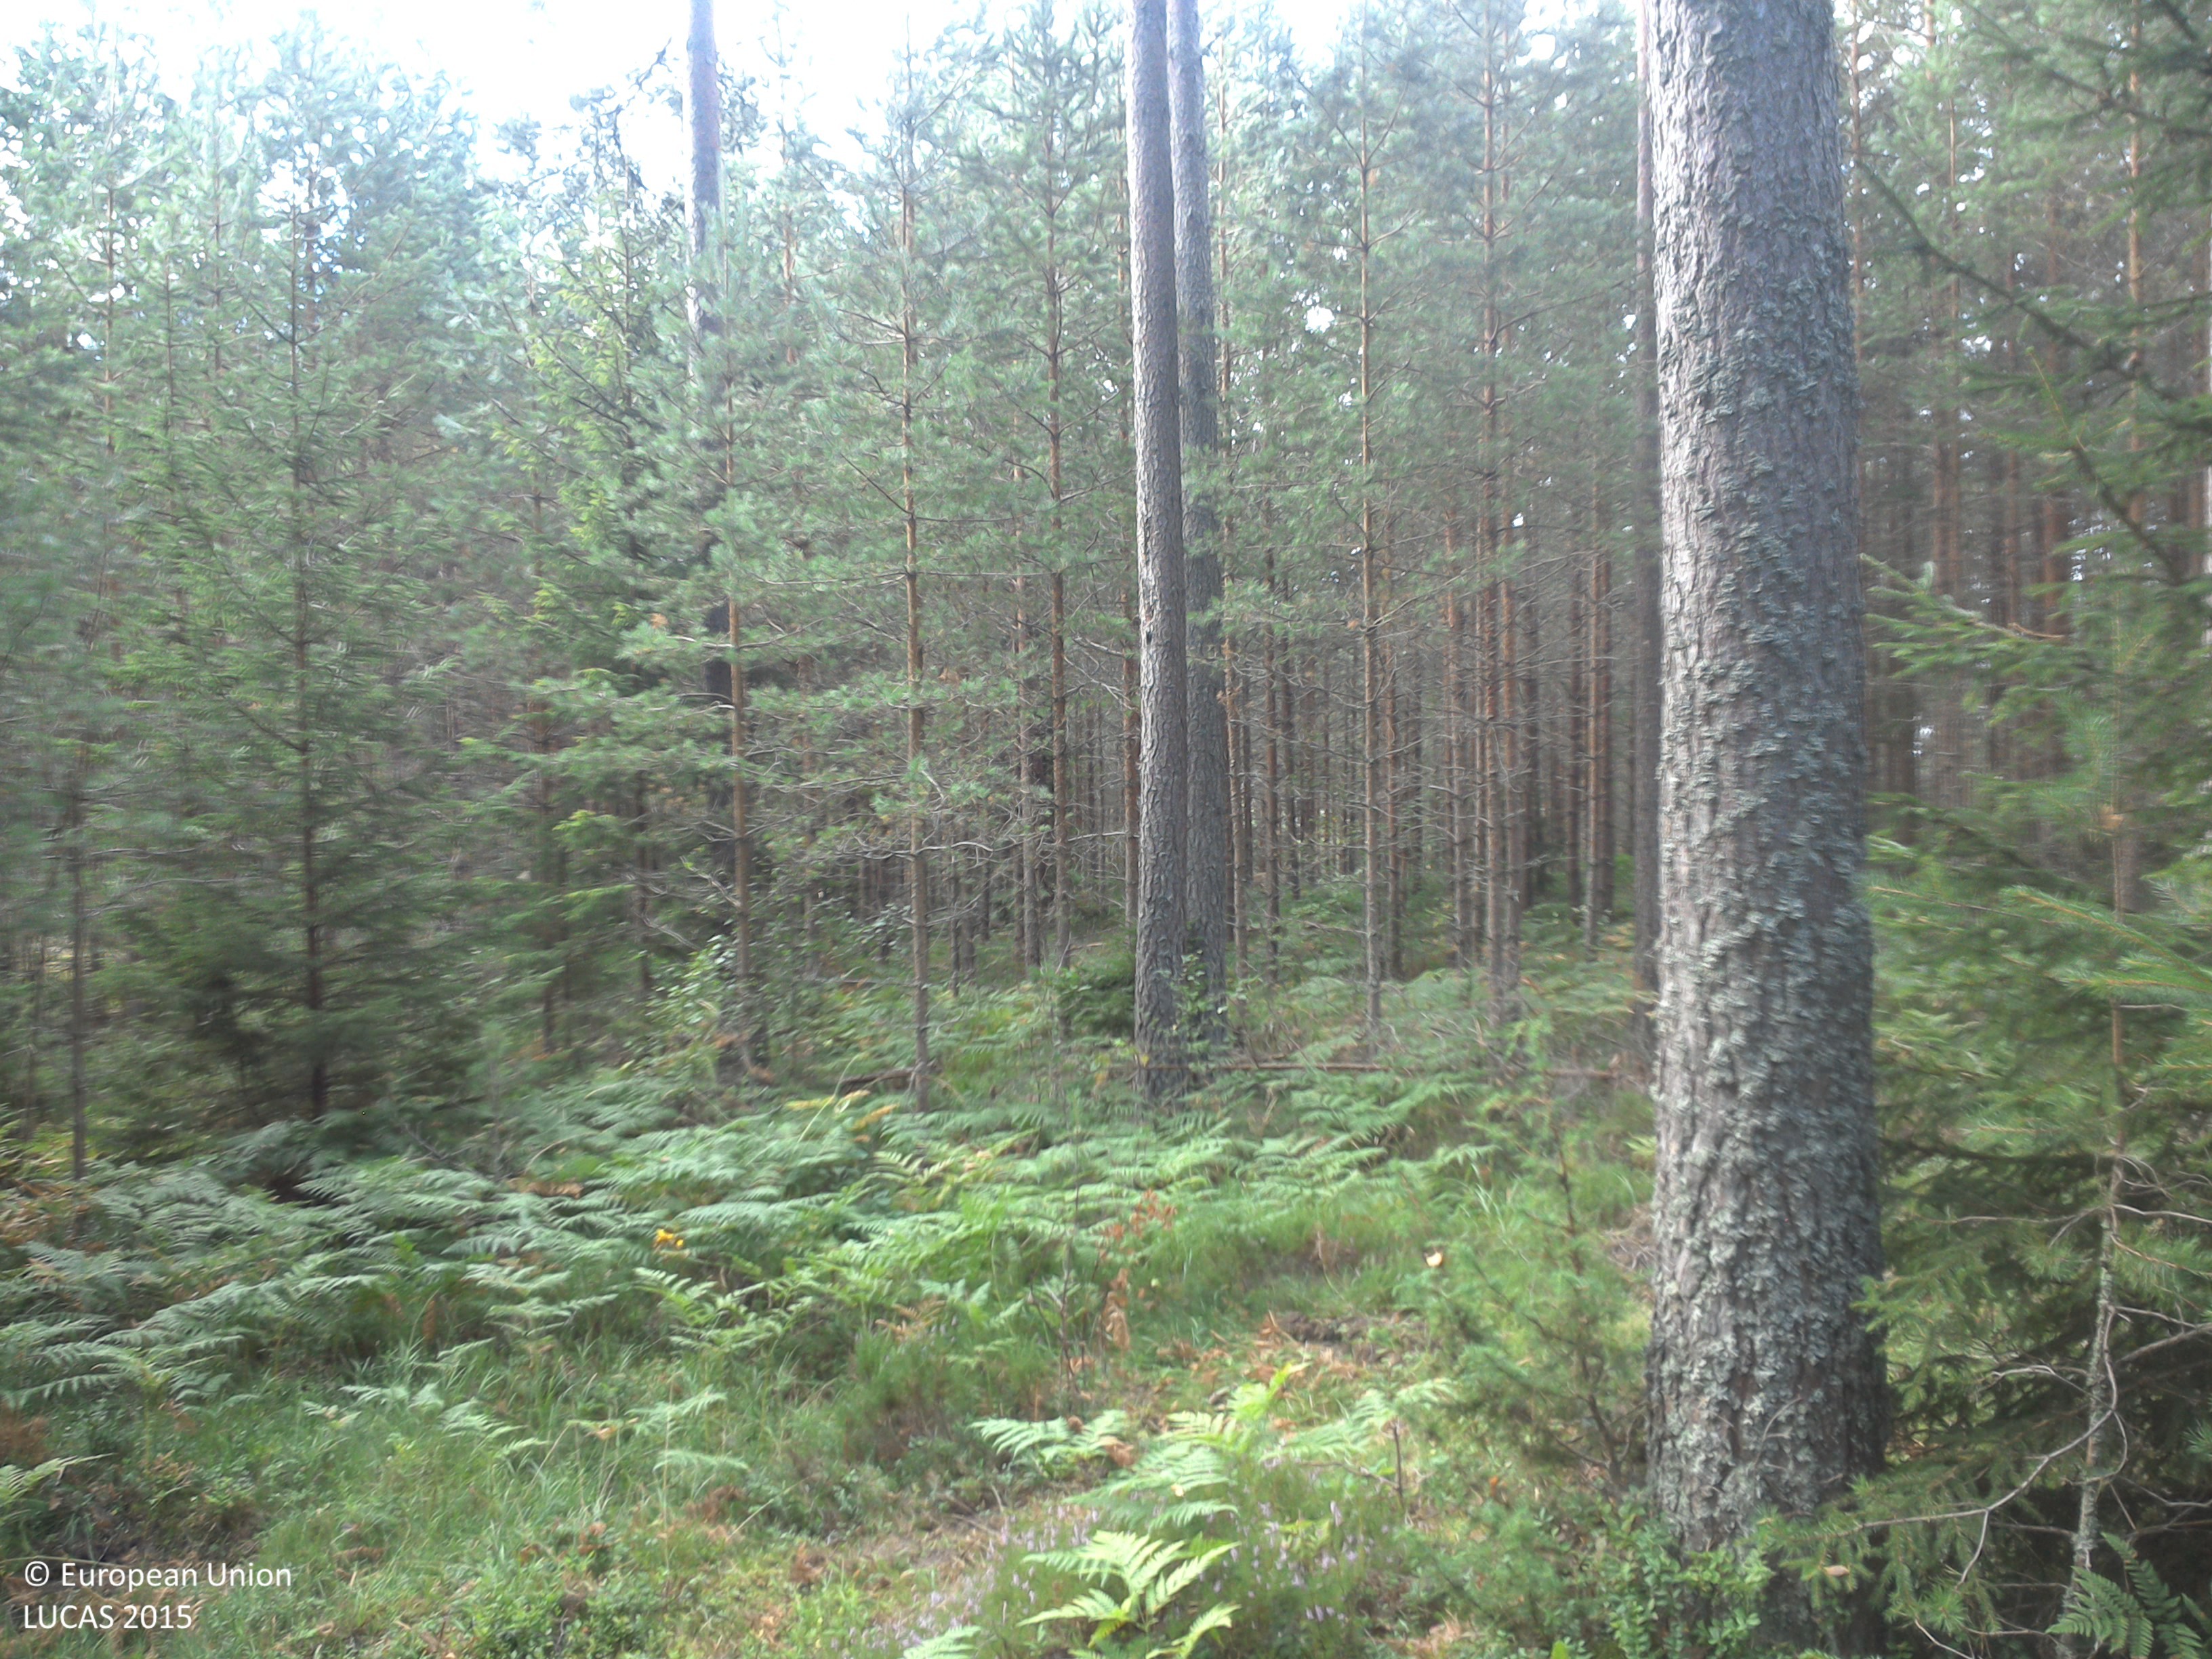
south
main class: Woodland
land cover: Pine dominated coniferous woodland
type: boreal forest
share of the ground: 25 - 50 %
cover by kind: herbaceous plants 50 %, coniferous forest trees 40 %, lichens and mosses 10 %
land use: Forestry
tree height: > 5 m
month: August
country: SE
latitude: 58.0183
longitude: 15.4632
